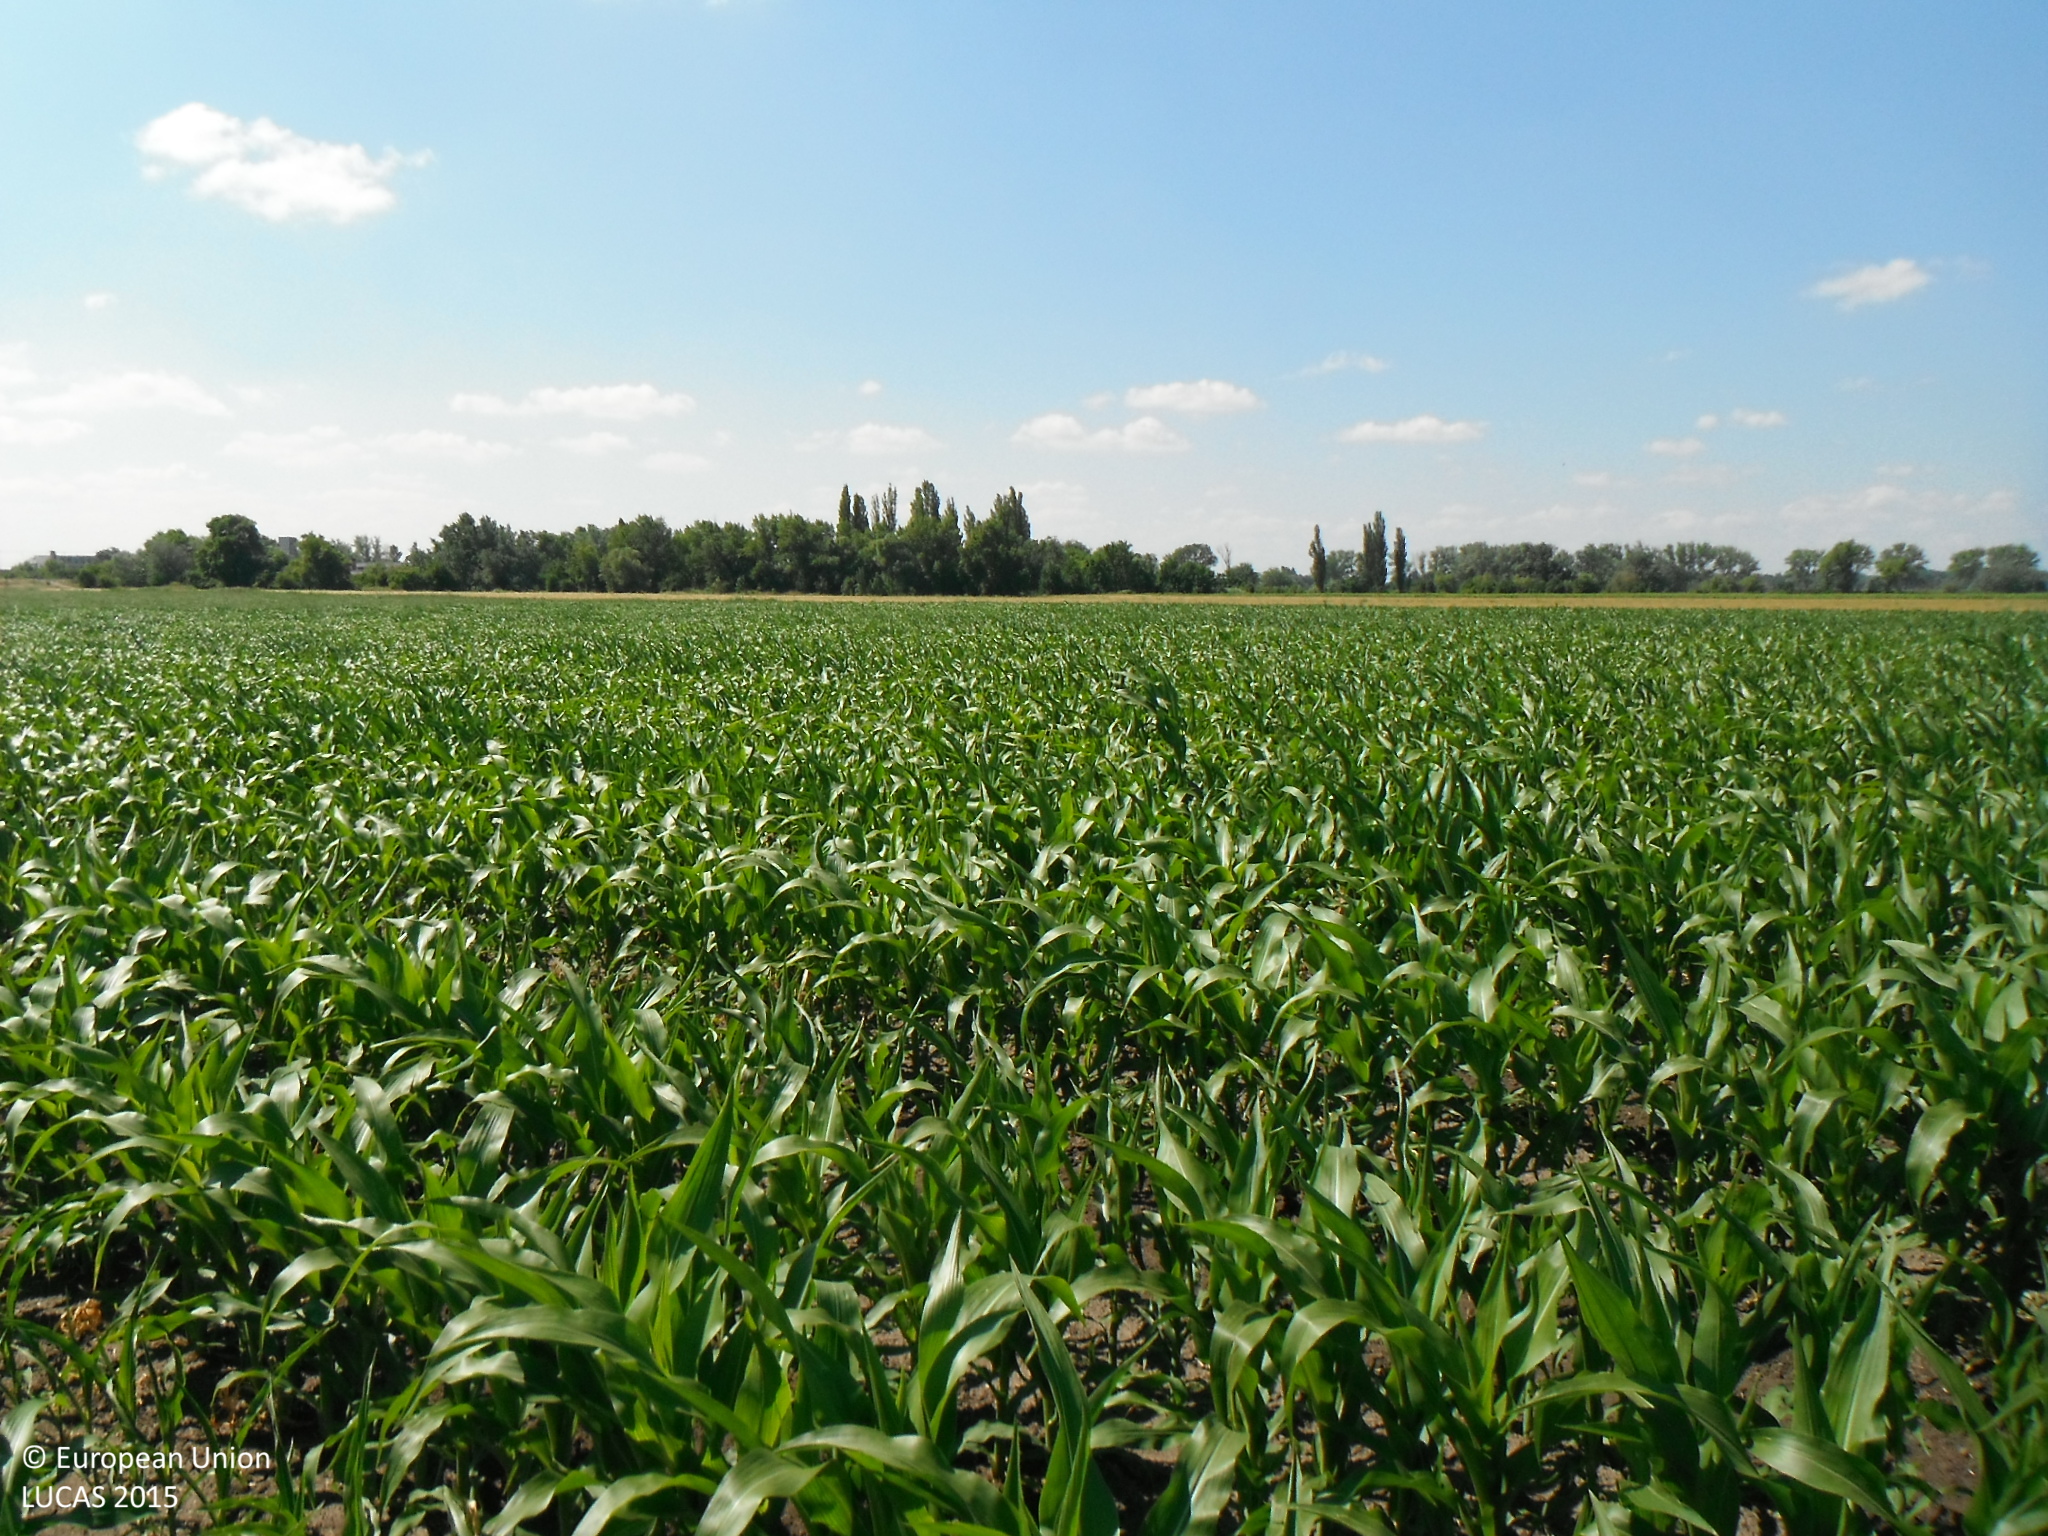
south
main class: Cropland
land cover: Maize
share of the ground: 50 - 75 %
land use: Agriculture (excluding fallow land and kitchen gardens)
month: June
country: SK
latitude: 47.7934
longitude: 18.1693
